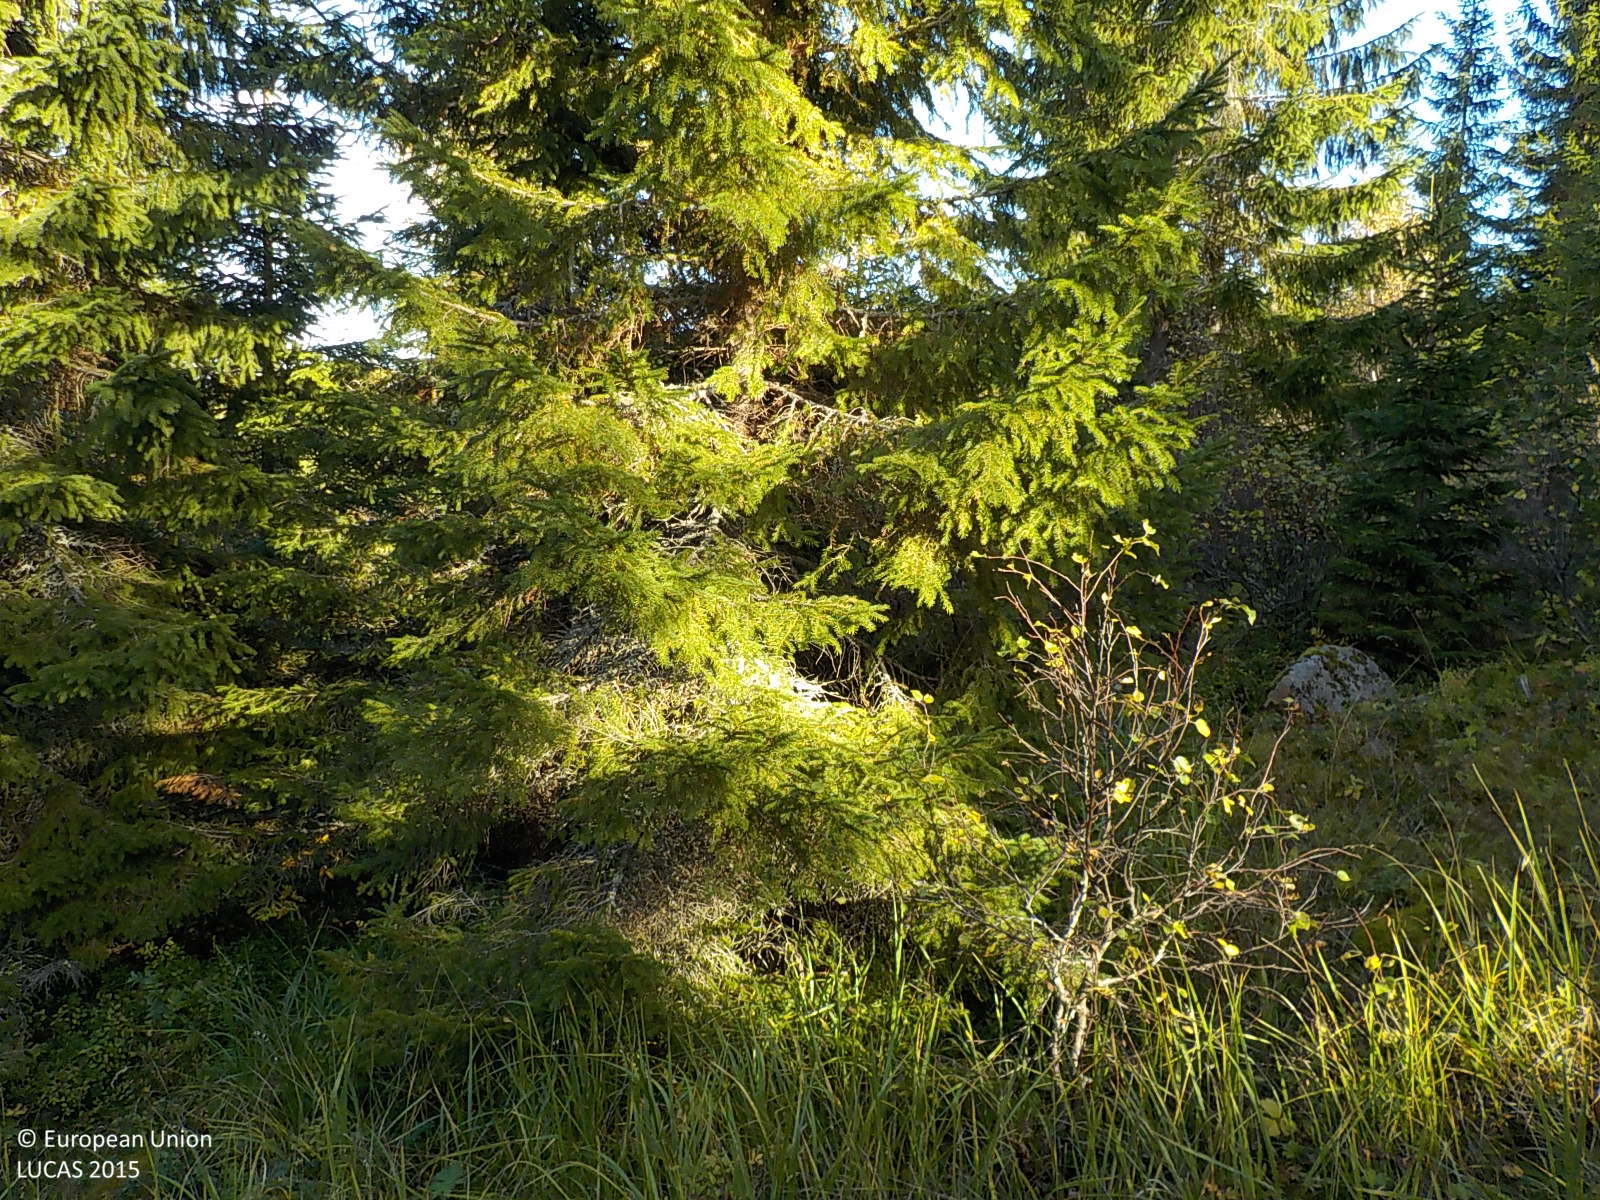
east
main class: Woodland
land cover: Spruce dominated mixed woodland
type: boreal forest
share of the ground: 50 - 75 %
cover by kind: coniferous forest trees 40 %, shrubs 35 %, broadleaved forest trees 25 %
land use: Forestry
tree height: > 5 m
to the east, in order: Spruce dominated mixed woodland; Shrubland without tree cover; Spruce dominated coniferous woodland; Spruce dominated mixed woodland; Lichens and moss; Spruce dominated mixed woodland
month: September
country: SE
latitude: 62.9449
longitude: 18.3152
